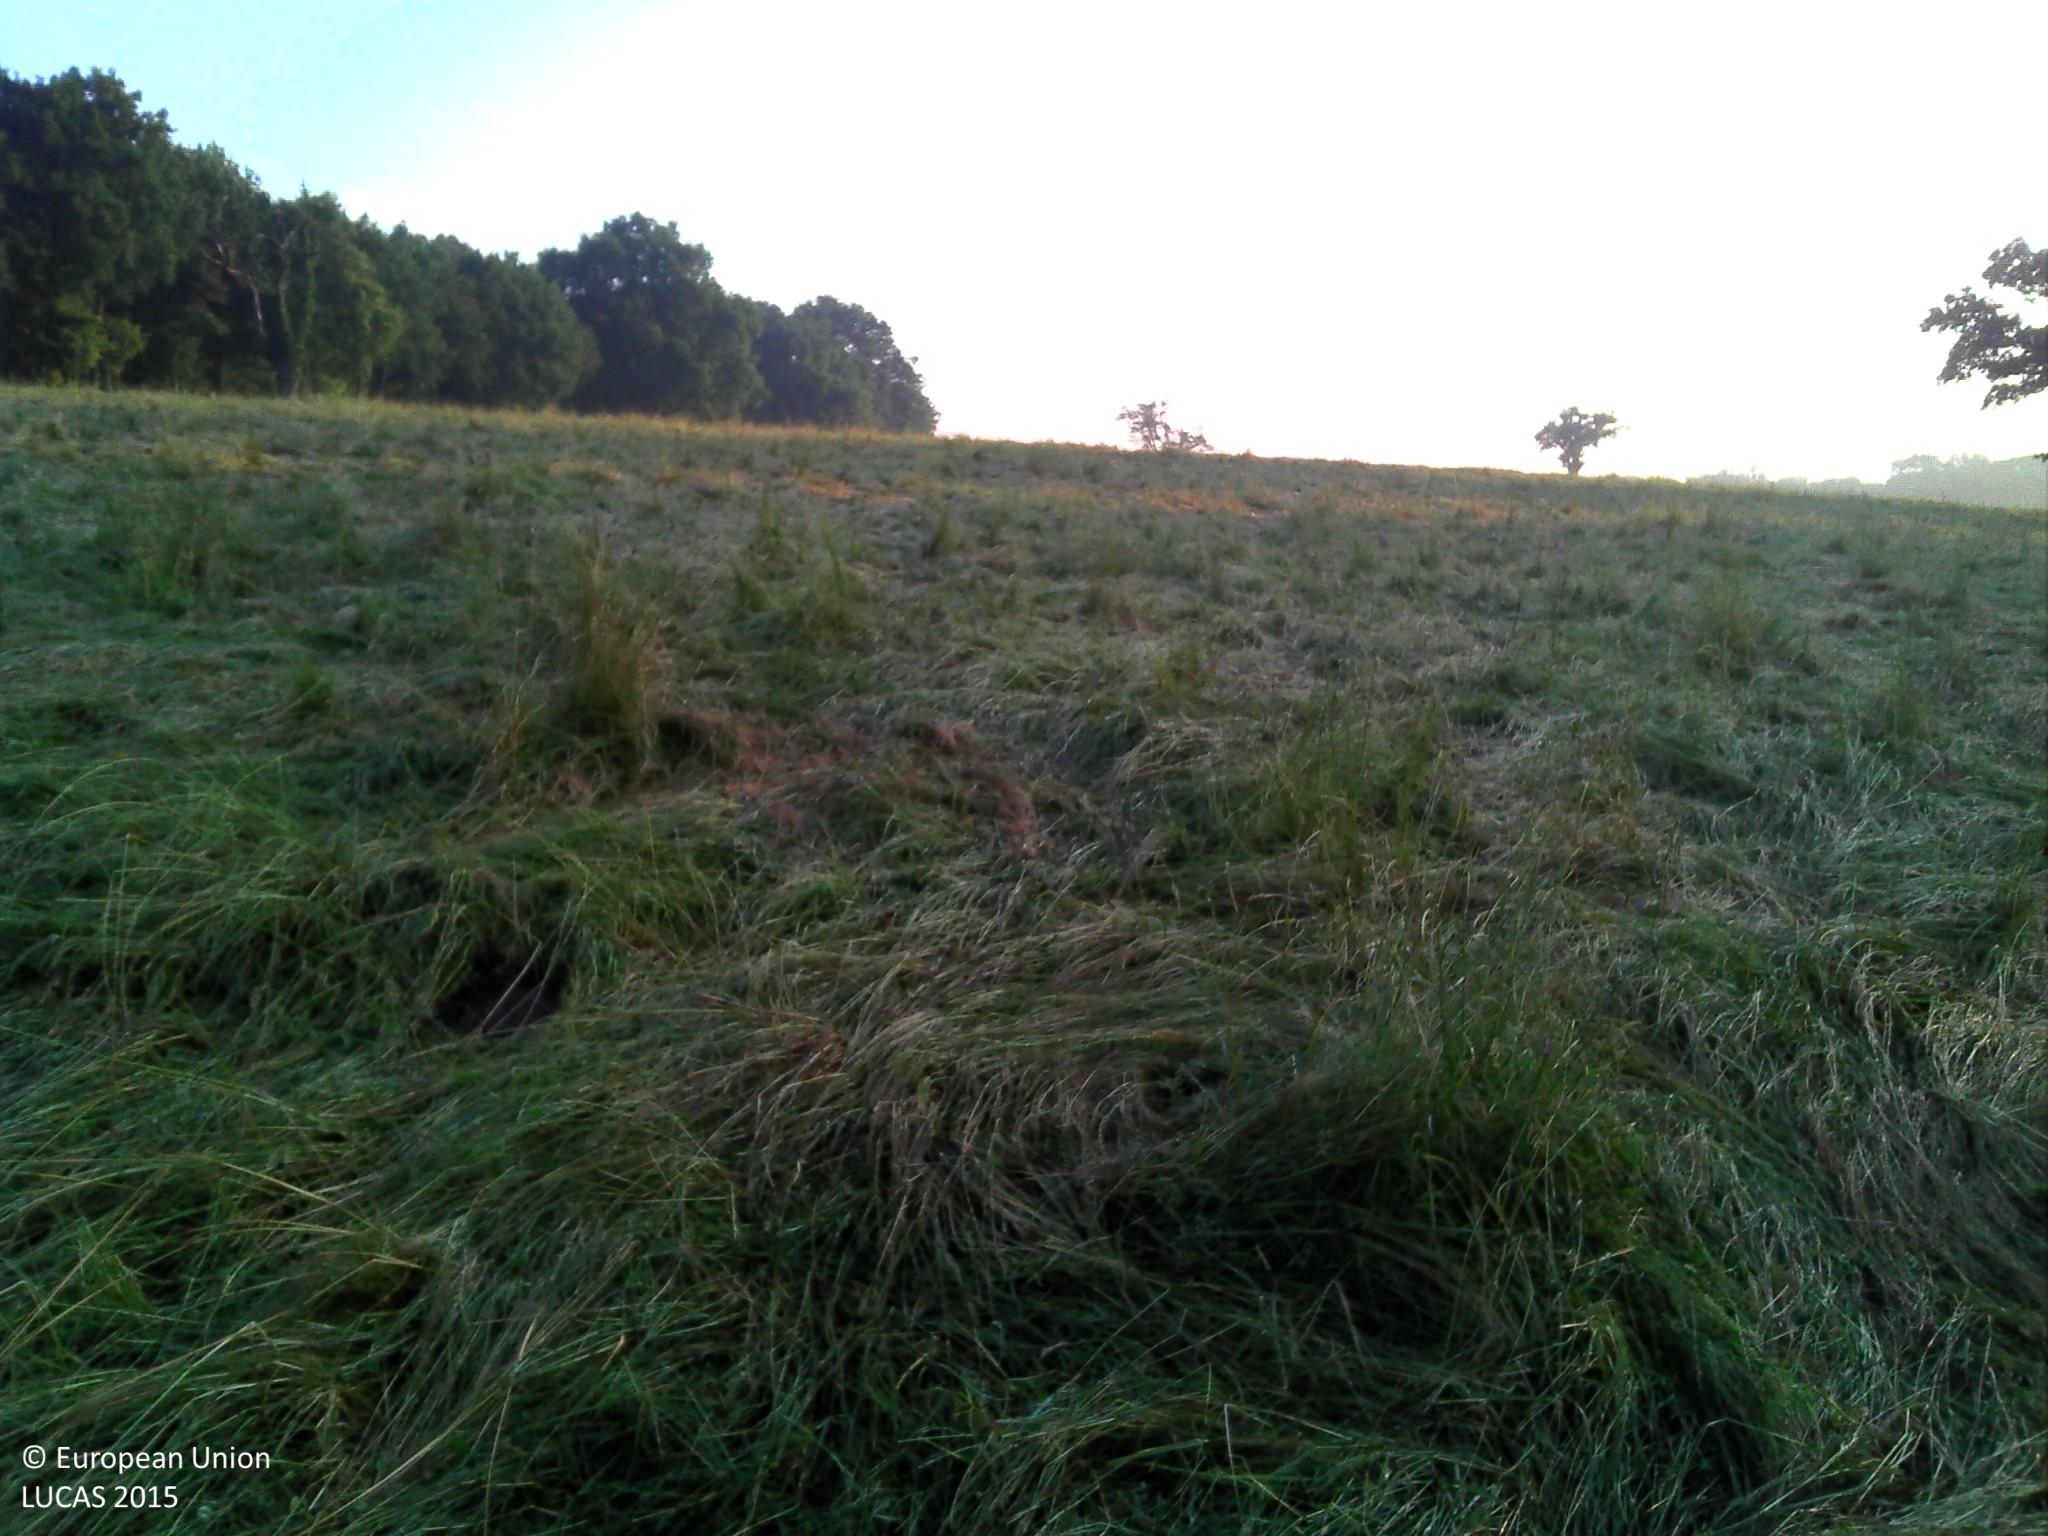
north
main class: Grassland
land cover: Grassland without tree/shrub cover
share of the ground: > 75 %
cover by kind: herbaceous plants 100 %
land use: Agriculture (excluding fallow land and kitchen gardens)
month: June
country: FR
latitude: 46.7492
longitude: 2.6514
